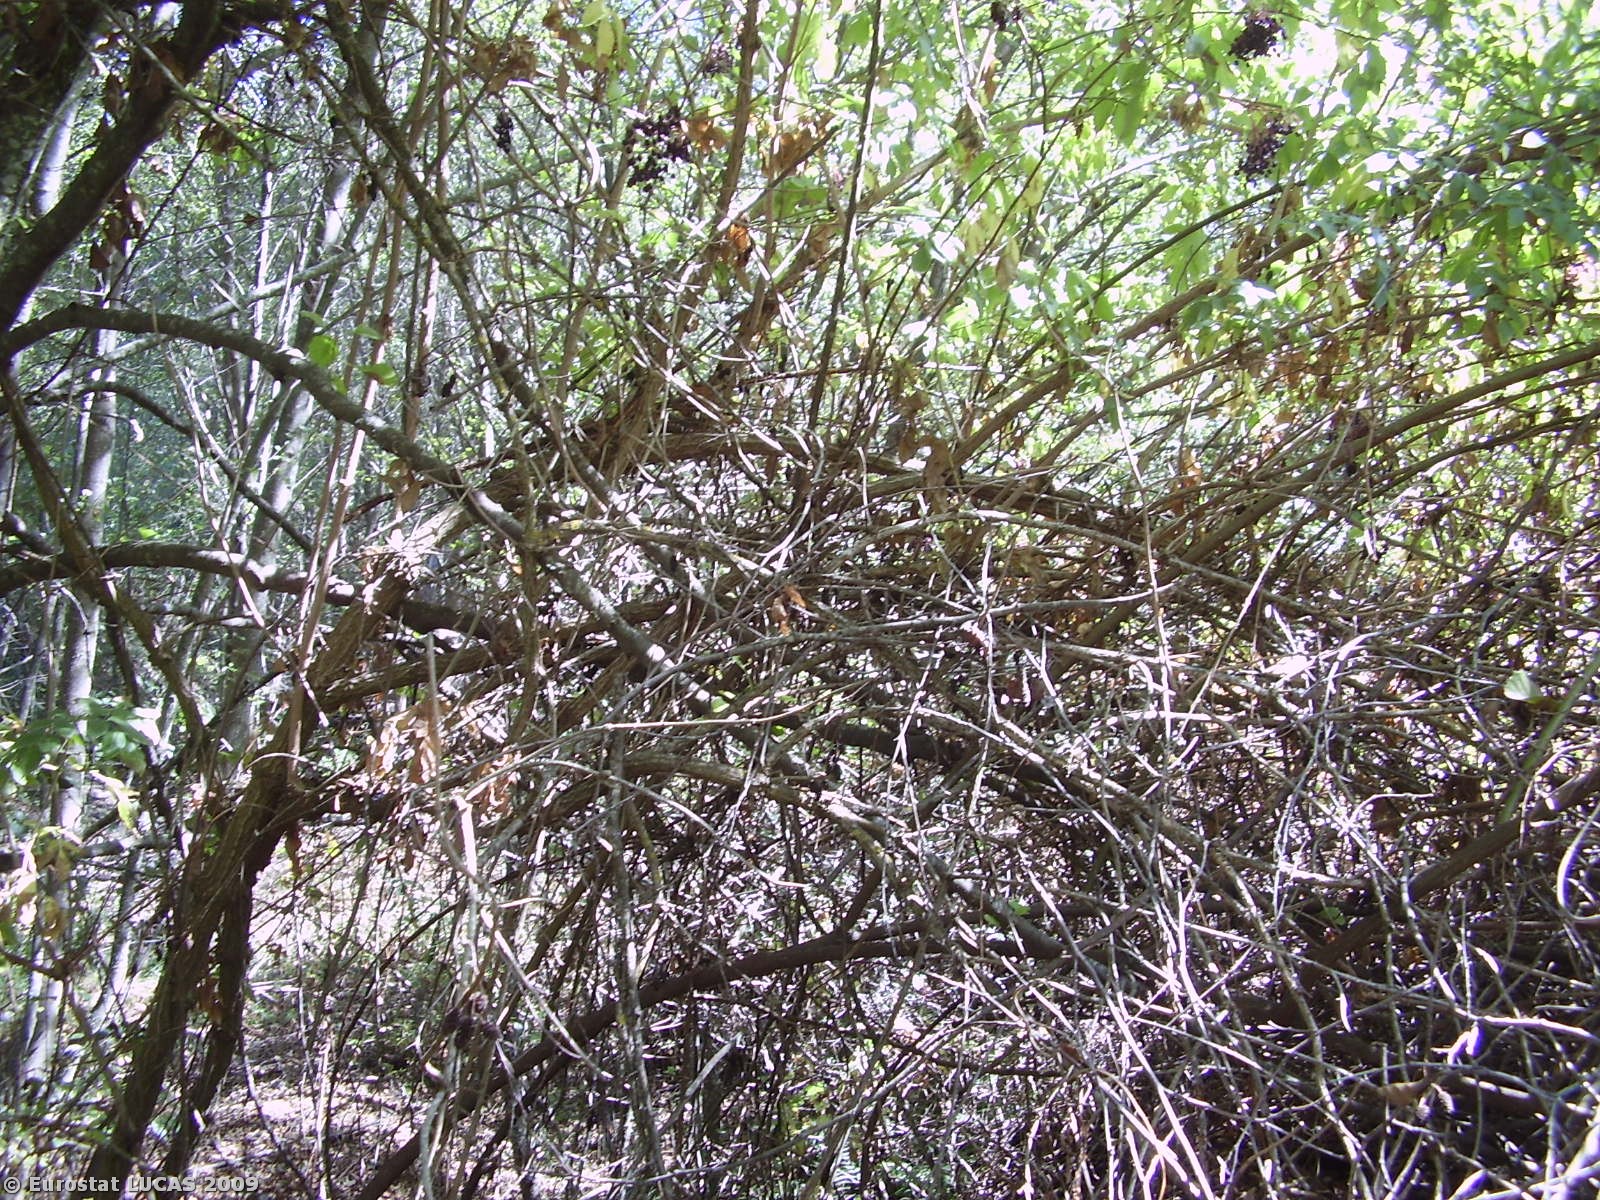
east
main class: Woodland
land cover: Broadleaved woodland
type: broadleaved evergreen forest
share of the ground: 10 - 25 %
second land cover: Shrubland with sparse tree cover
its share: > 75 %
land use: Forestry
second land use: Fallow land
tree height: > 5 m
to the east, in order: Broadleaved woodland; Shrubland with sparse tree cover; Broadleaved woodland; Olive groves; Broadleaved woodland; Rivers and streams
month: September
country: PT
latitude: 41.1273
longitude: -6.9138
